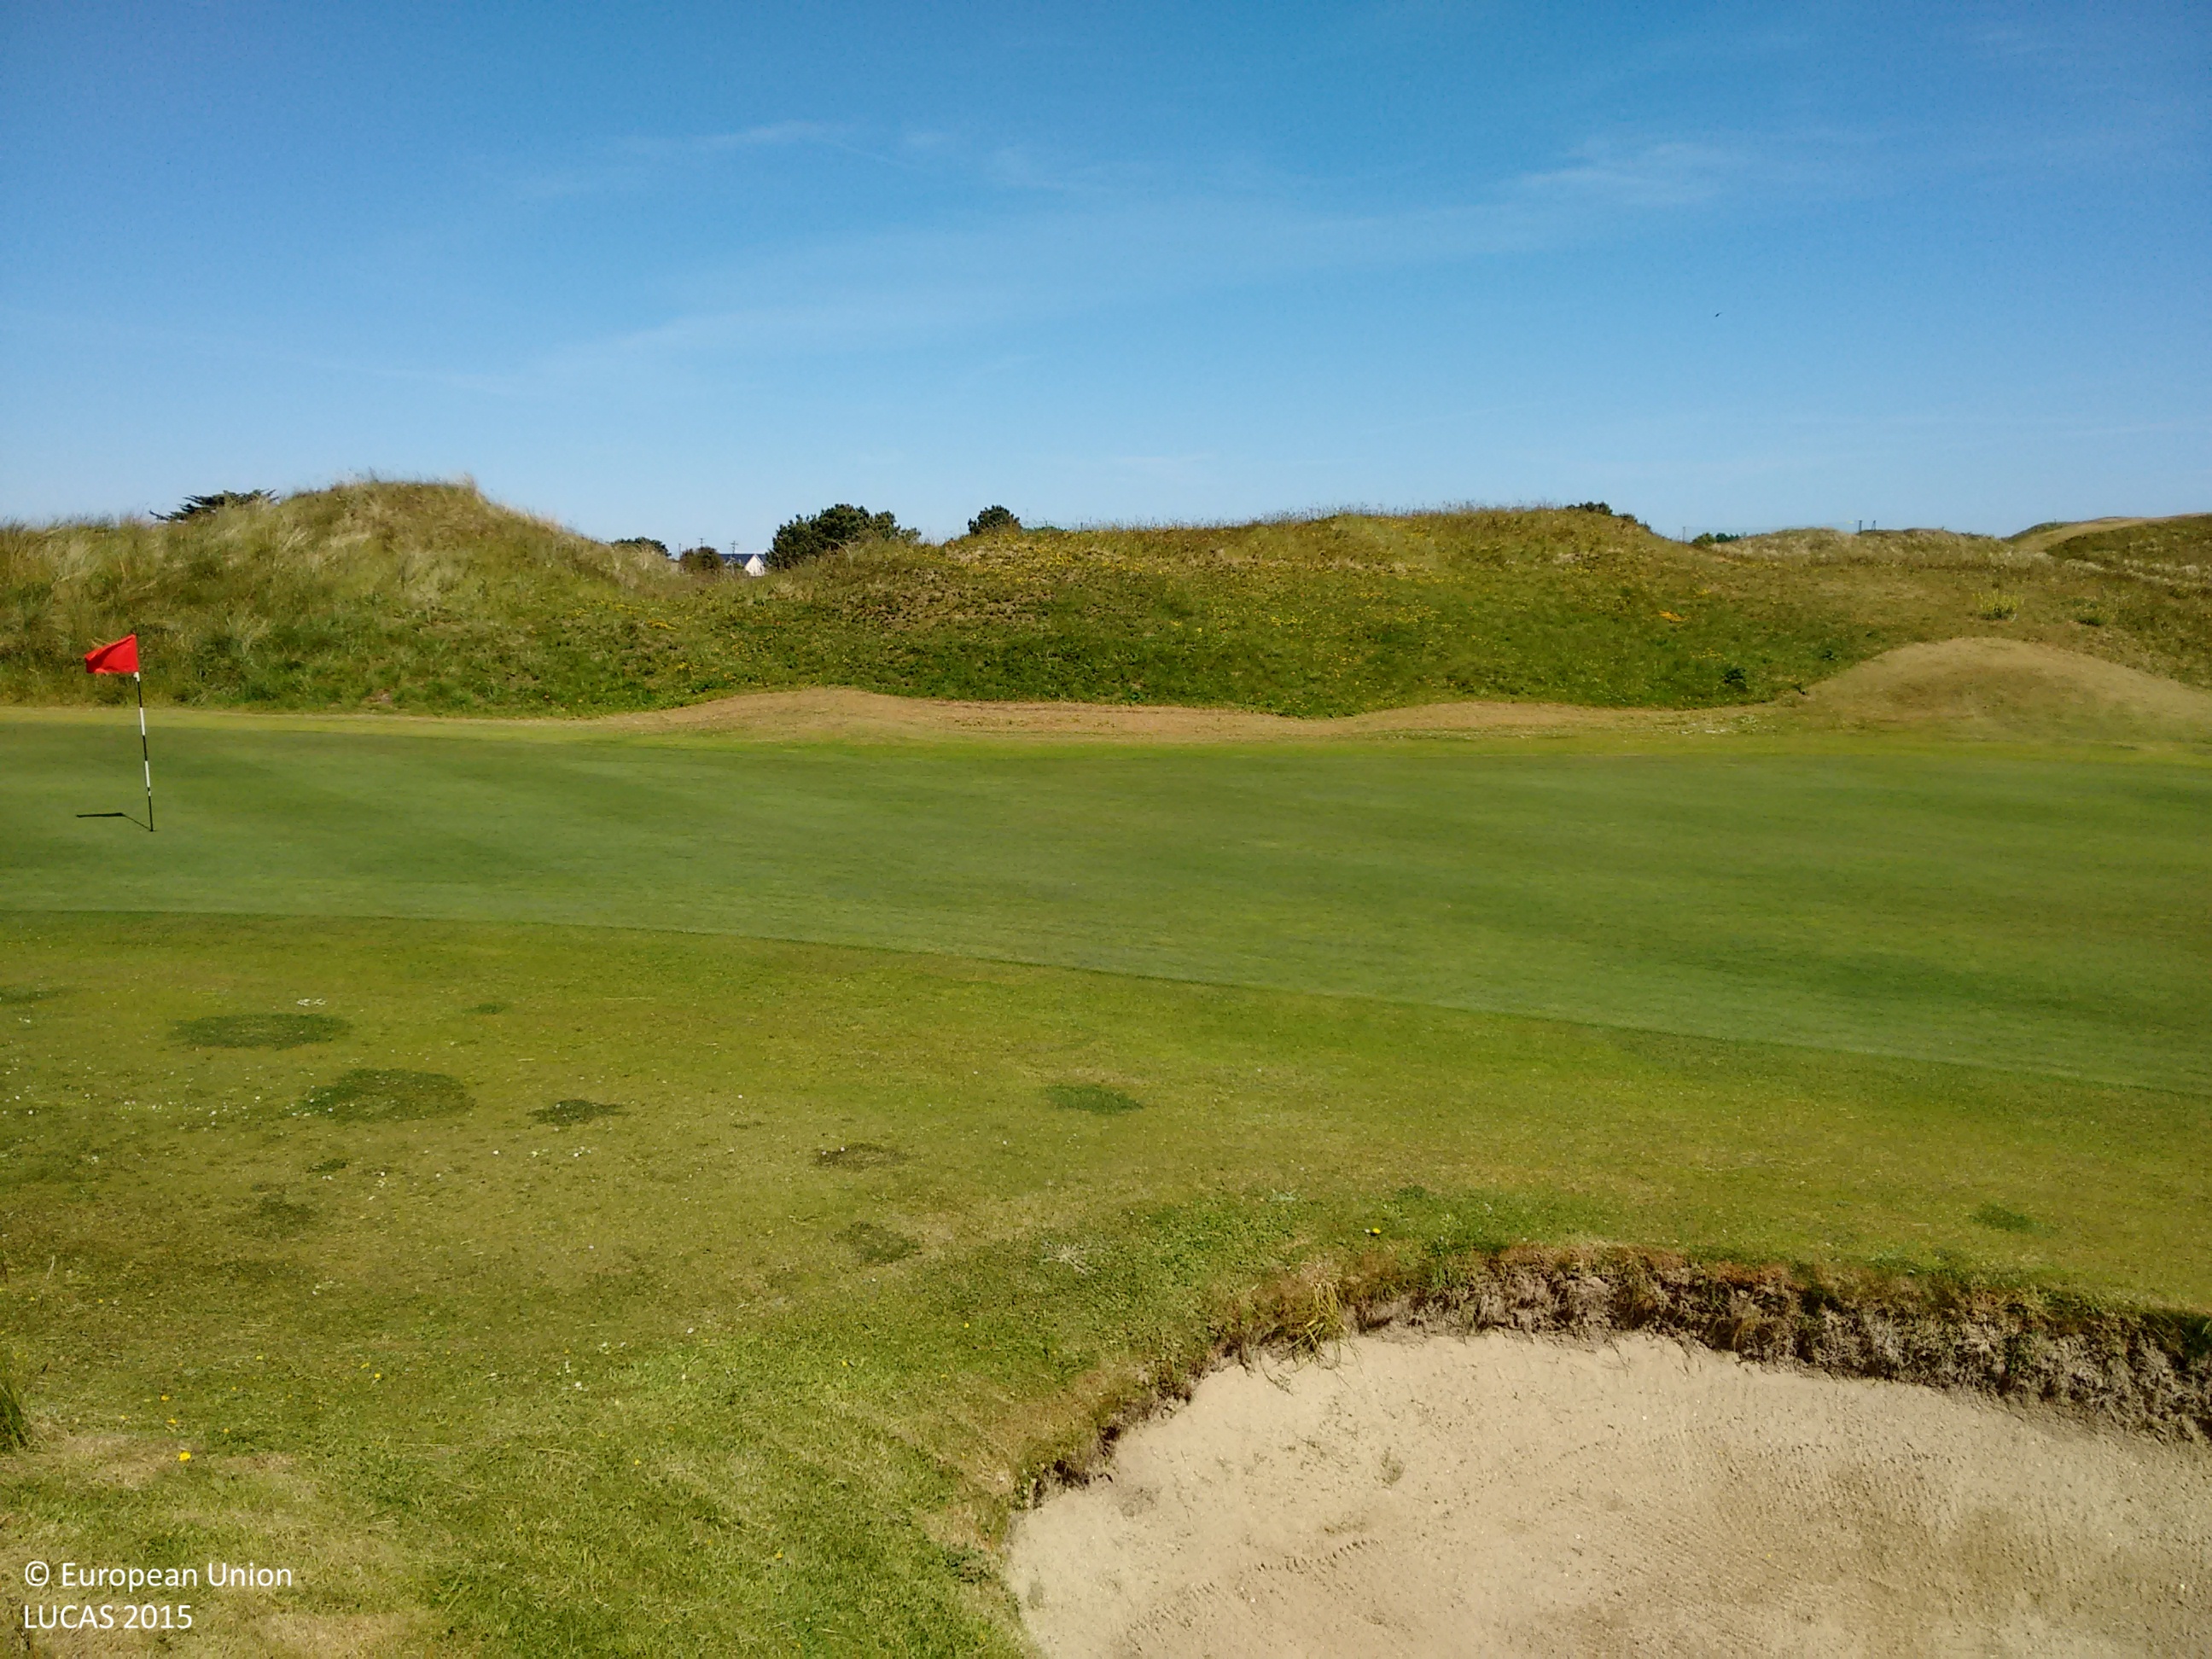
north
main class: Grassland
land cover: Grassland without tree/shrub cover
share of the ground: > 75 %
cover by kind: herbaceous plants 95 %, unconsolidated bare surface 5 %
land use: Sport
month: June
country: IE
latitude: 53.4670
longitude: -6.1287
